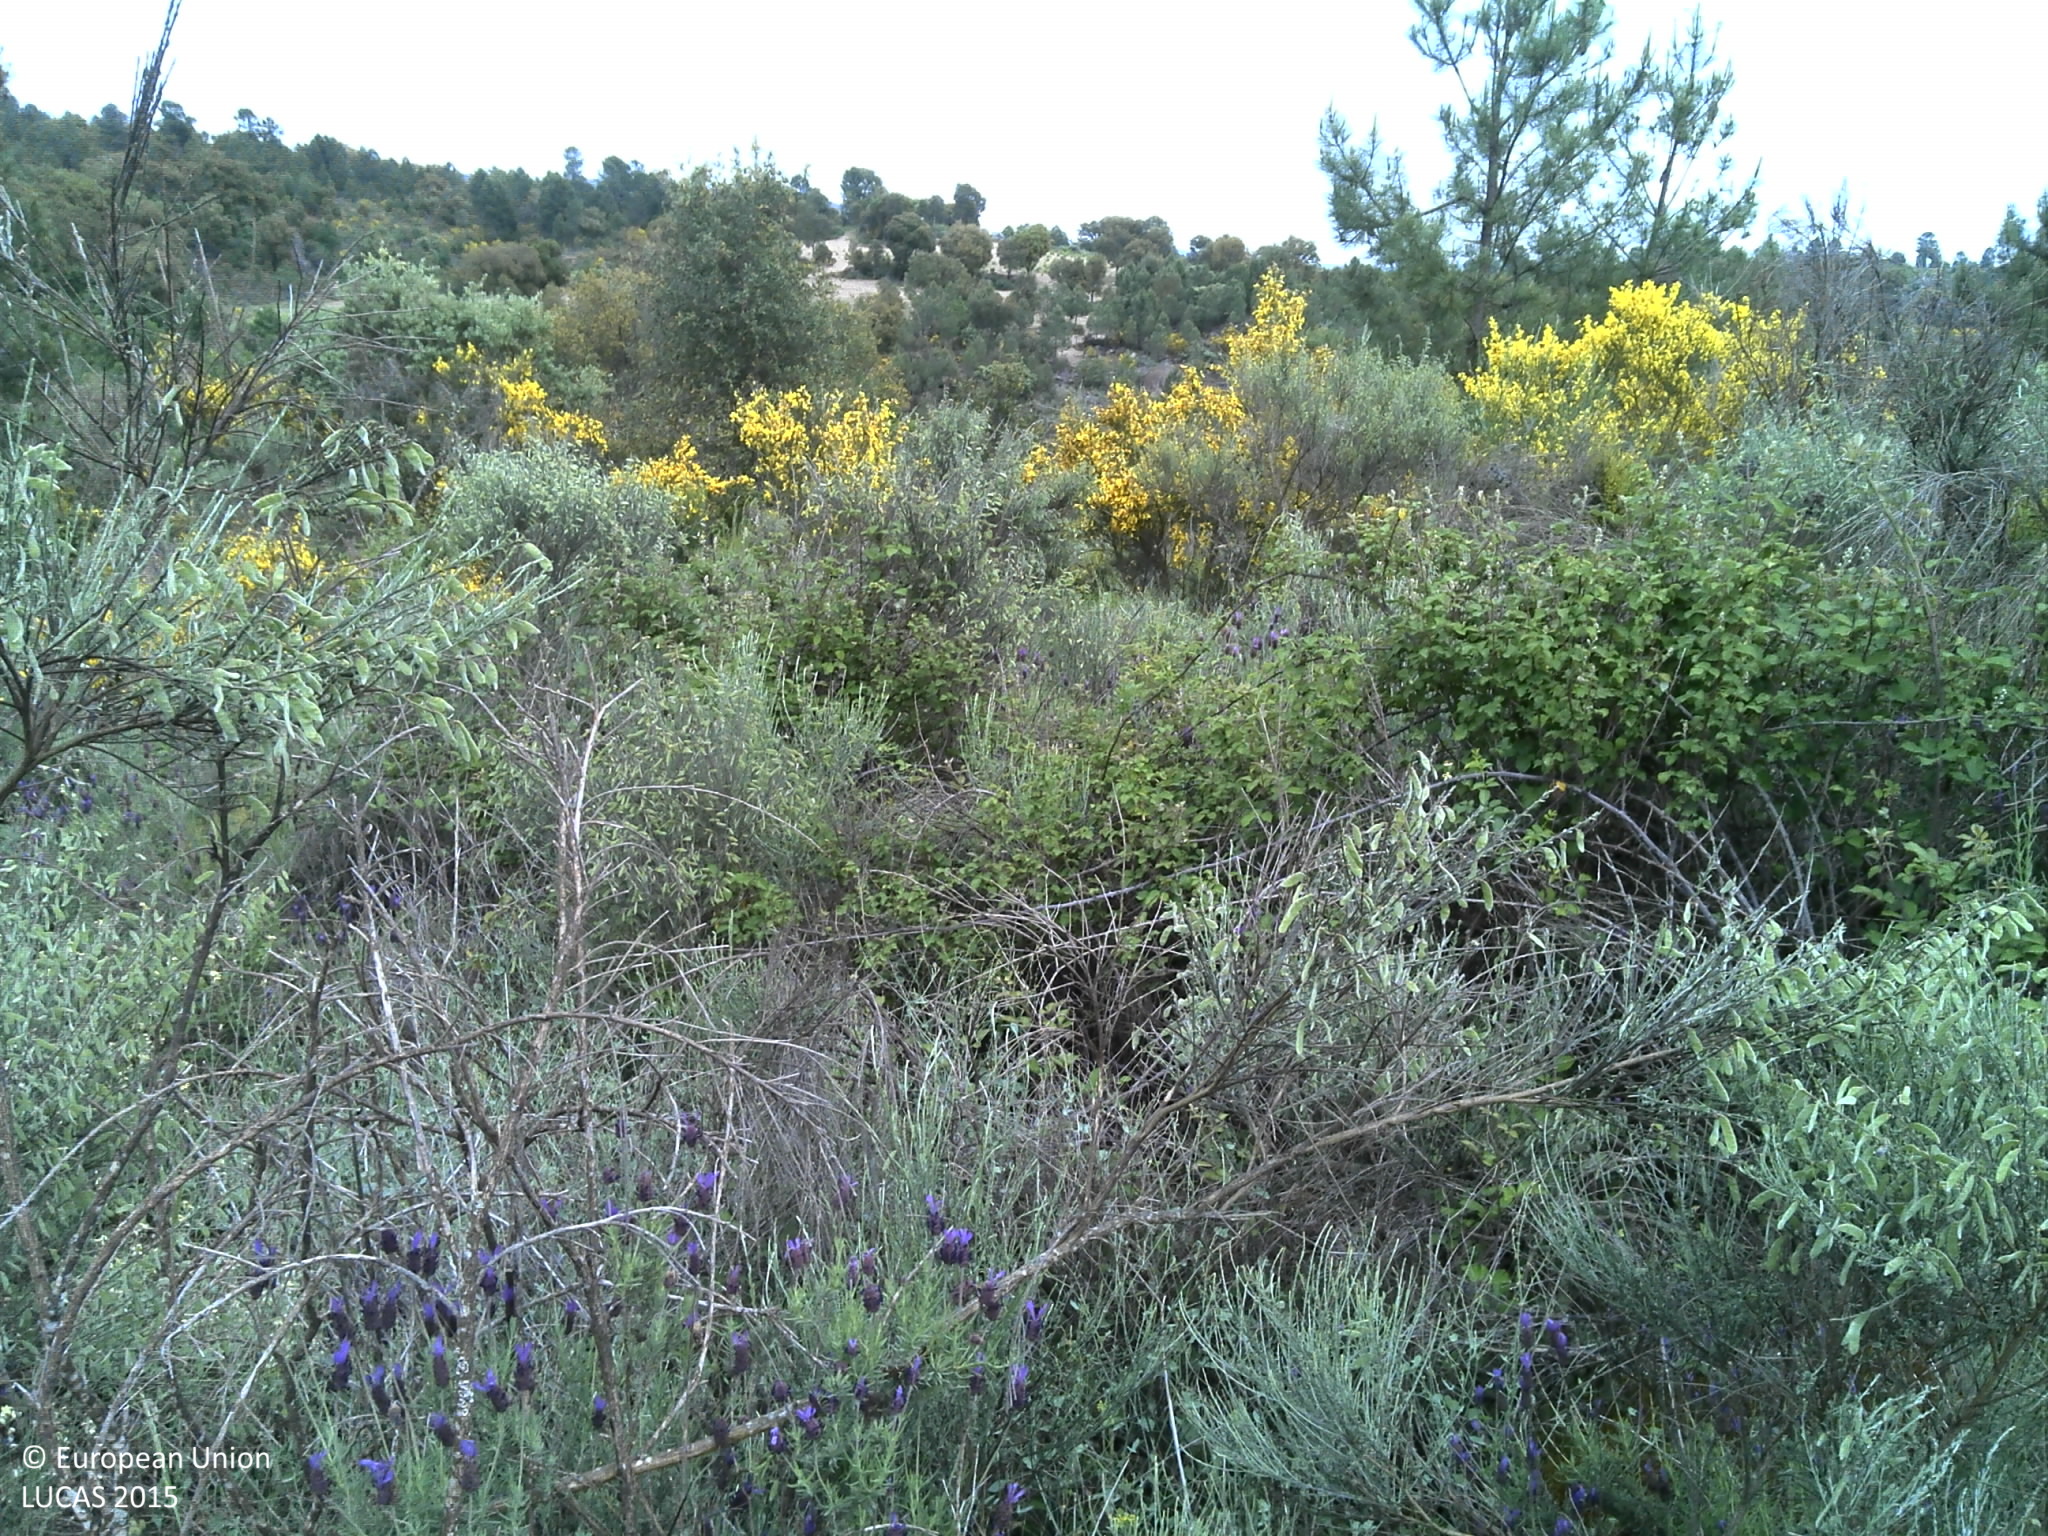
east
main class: Shrubland
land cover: Shrubland with sparse tree cover
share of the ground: > 75 %
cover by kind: shrubs 90 %, broadleaved forest trees 5 %, unconsolidated bare surface 5 %
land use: Abandoned areas
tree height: > 5 m
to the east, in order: Shrubland with sparse tree cover; Olive groves; Dry stone walls; Shrubland with sparse tree cover; Grassland with sparse tree/shrub cover; Abandoned hedges; Grassland without tree/shrub cover; Abandoned hedges; Grass margins; Tracks; Grass margins; Dry stone walls; Olive groves; Grassland with sparse tree/shrub cover; Shrubland with sparse tree cover; Pine dominated mixed woodland
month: May
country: PT
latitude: 41.6731
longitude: -7.1656
